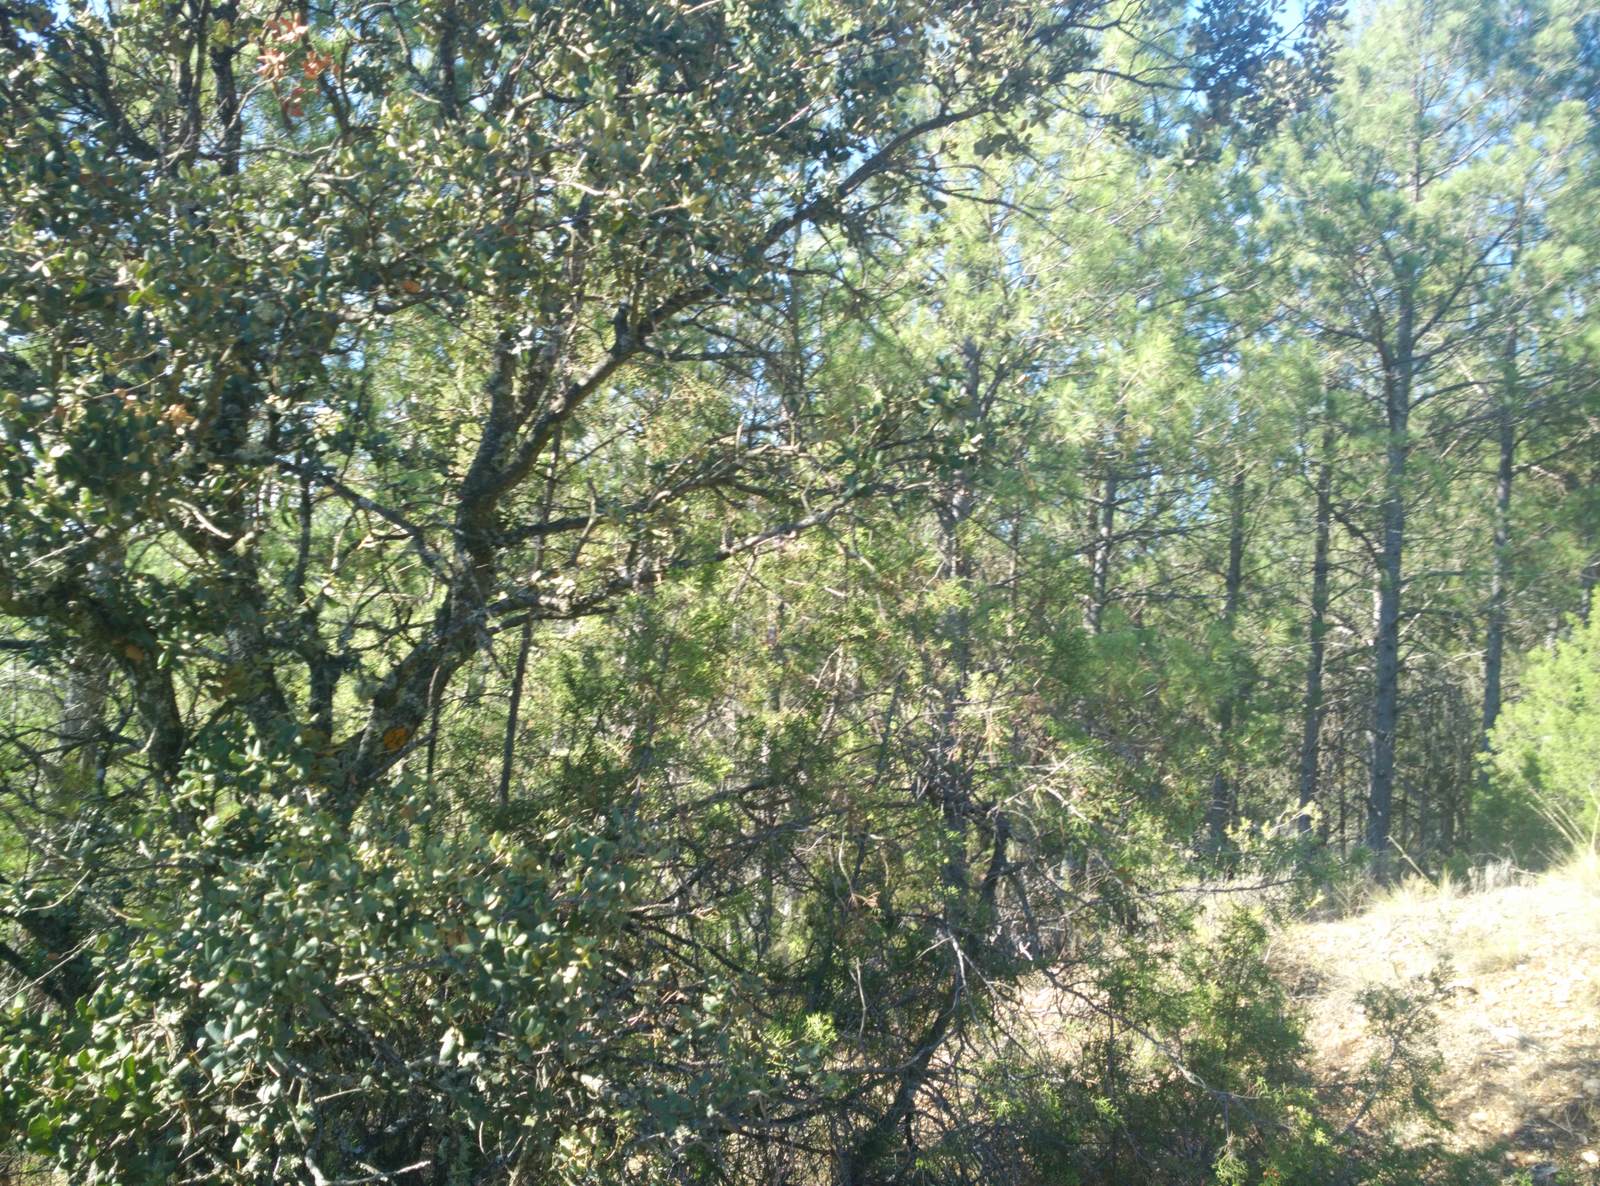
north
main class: Woodland
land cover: Pine dominated mixed woodland
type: coniferous forest of the mediterranean region
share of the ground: > 75 %
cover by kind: coniferous forest trees 45 %, broadleaved forest trees 30 %, unconsolidated bare surface 15 %, shrubs 10 %
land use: Forestry
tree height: > 5 m
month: July
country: ES
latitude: 40.7738
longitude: -2.6952
